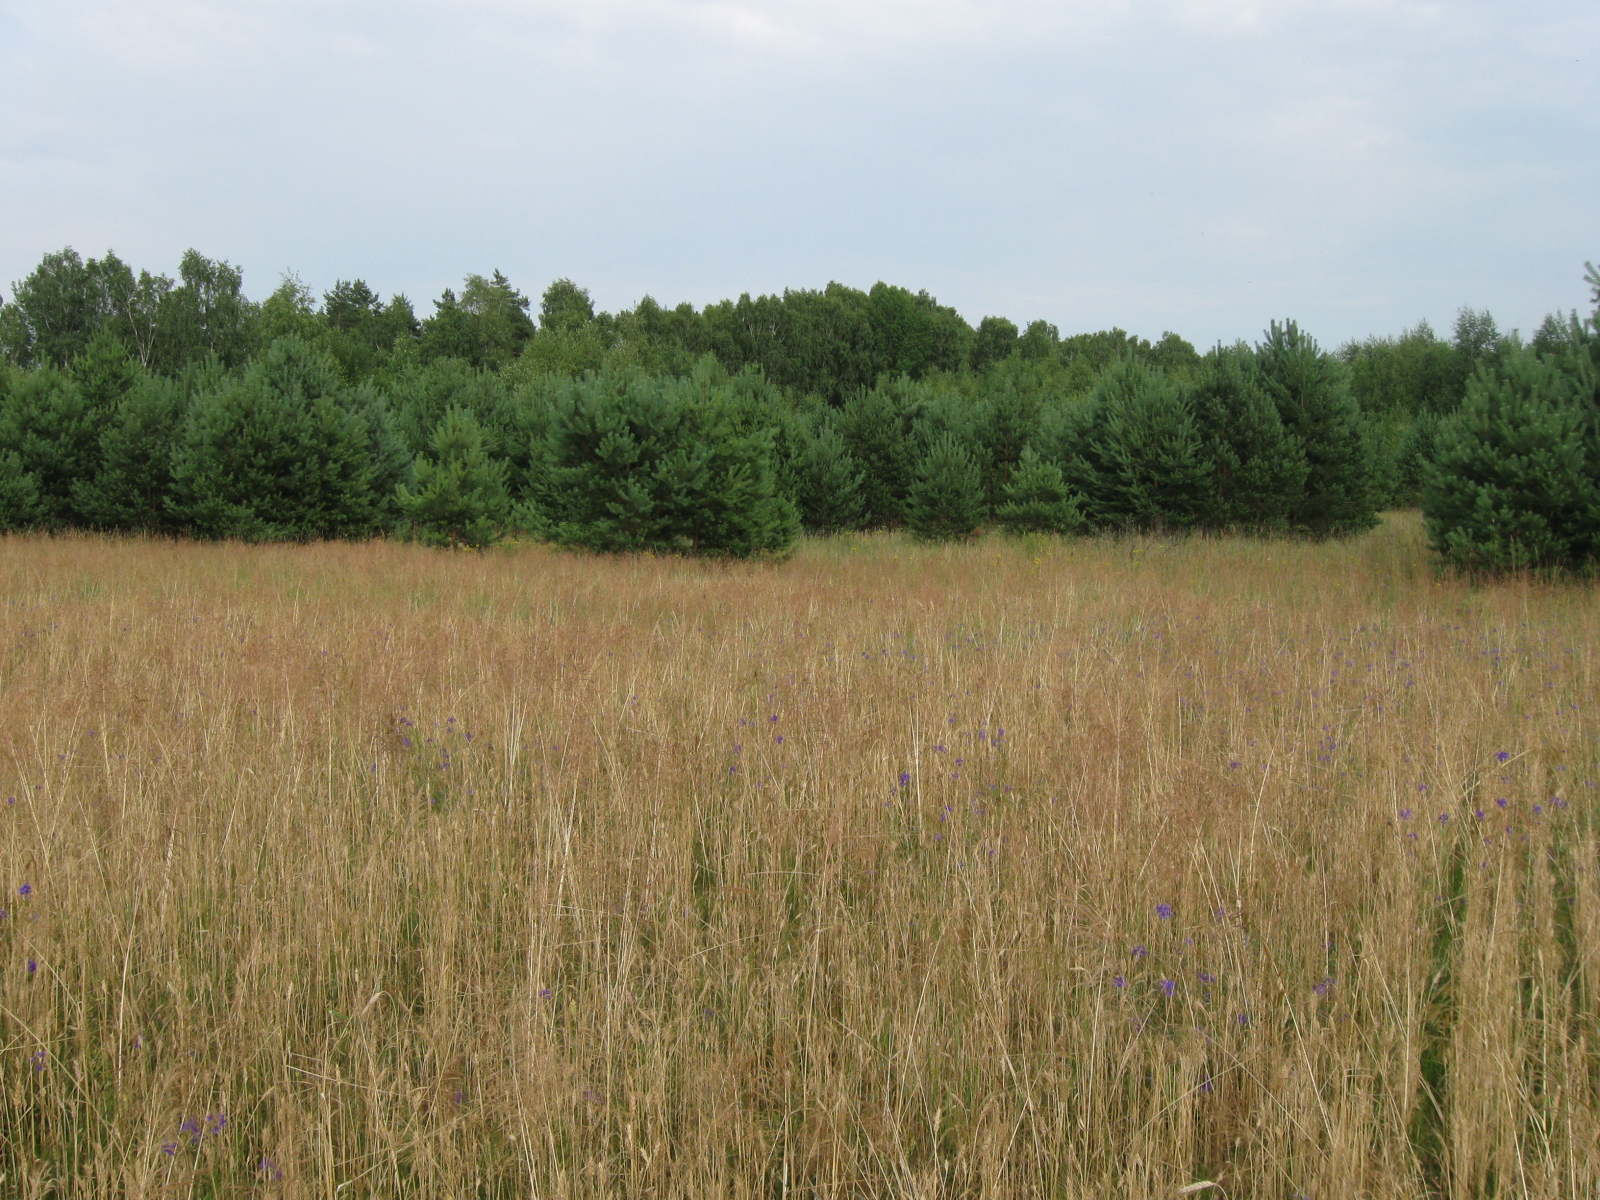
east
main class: Cropland
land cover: Durum wheat
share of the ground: > 75 %
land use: Agriculture (excluding fallow land and kitchen gardens)
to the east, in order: Durum wheat; Electric lines; Durum wheat; Pine dominated coniferous woodland; Pine dominated mixed woodland; Broadleaved woodland
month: July
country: LT
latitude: 54.6130
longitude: 23.9807
